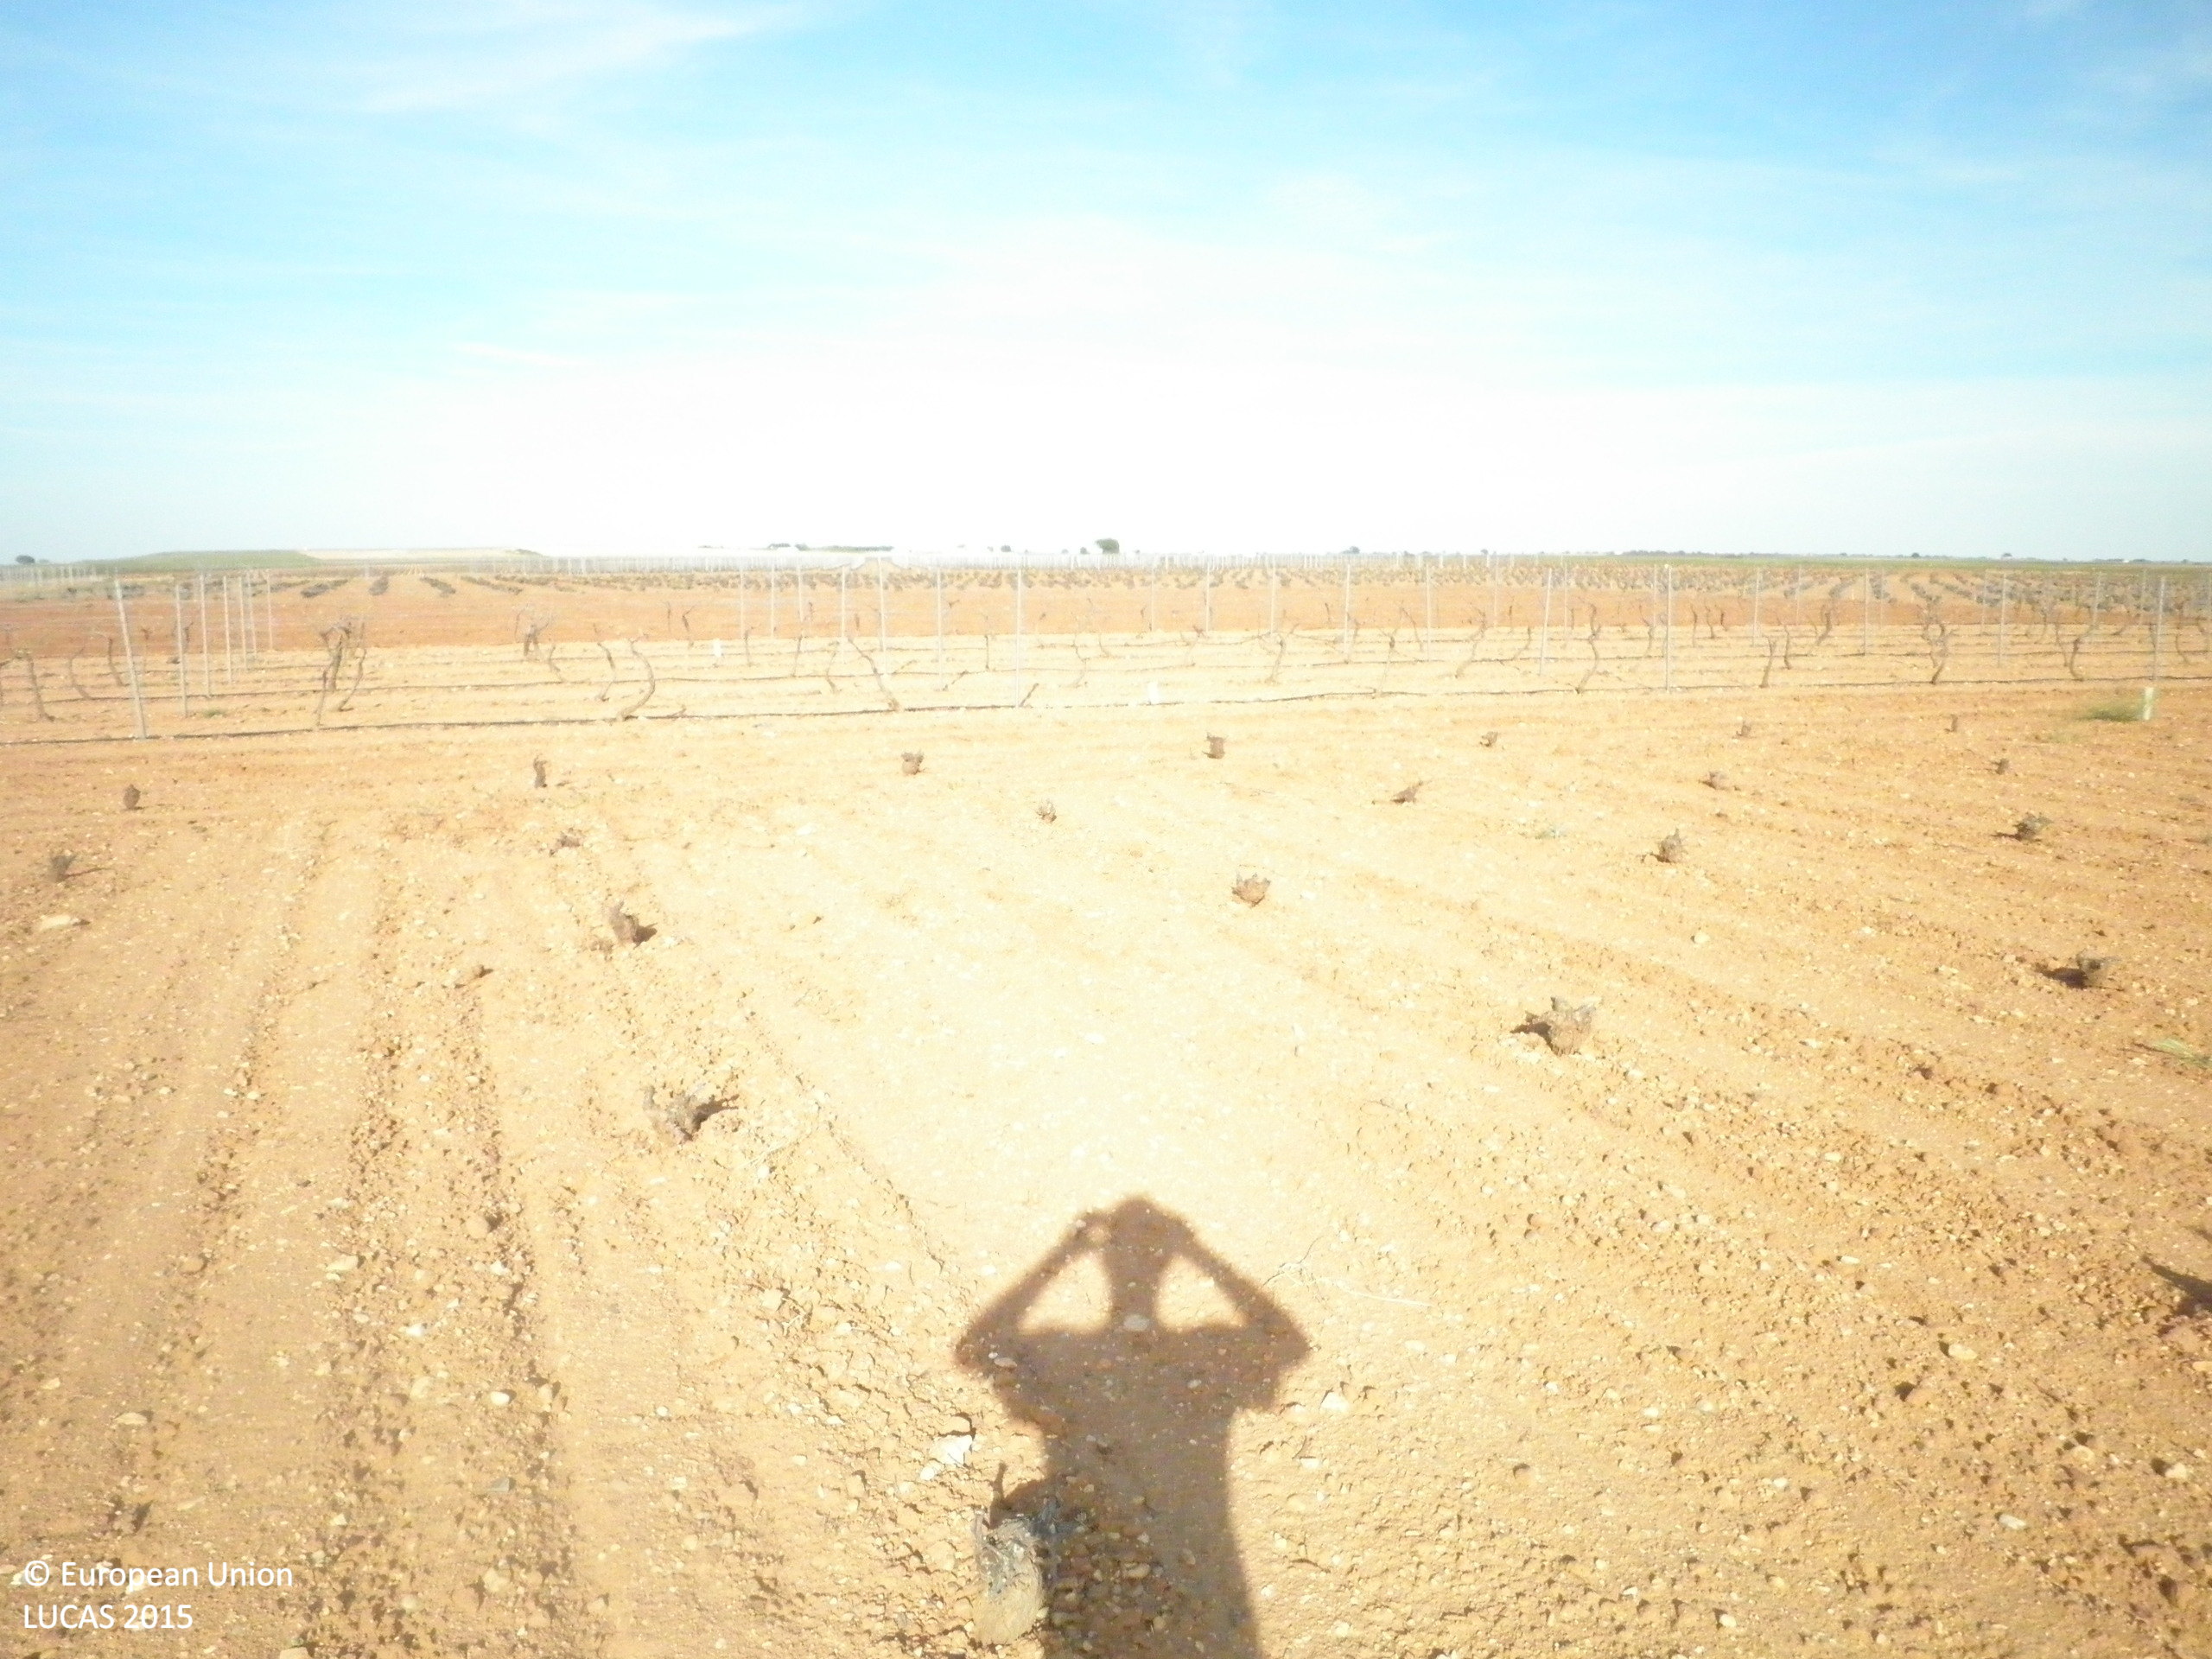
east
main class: Cropland
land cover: Vineyards
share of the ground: < 10 %
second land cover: Other bare soil
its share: > 75 %
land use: Agriculture (excluding fallow land and kitchen gardens)
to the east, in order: Vineyards; Other bare soil; Vineyards; Tracks; Vineyards
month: April
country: ES
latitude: 39.3594
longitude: -2.7440
